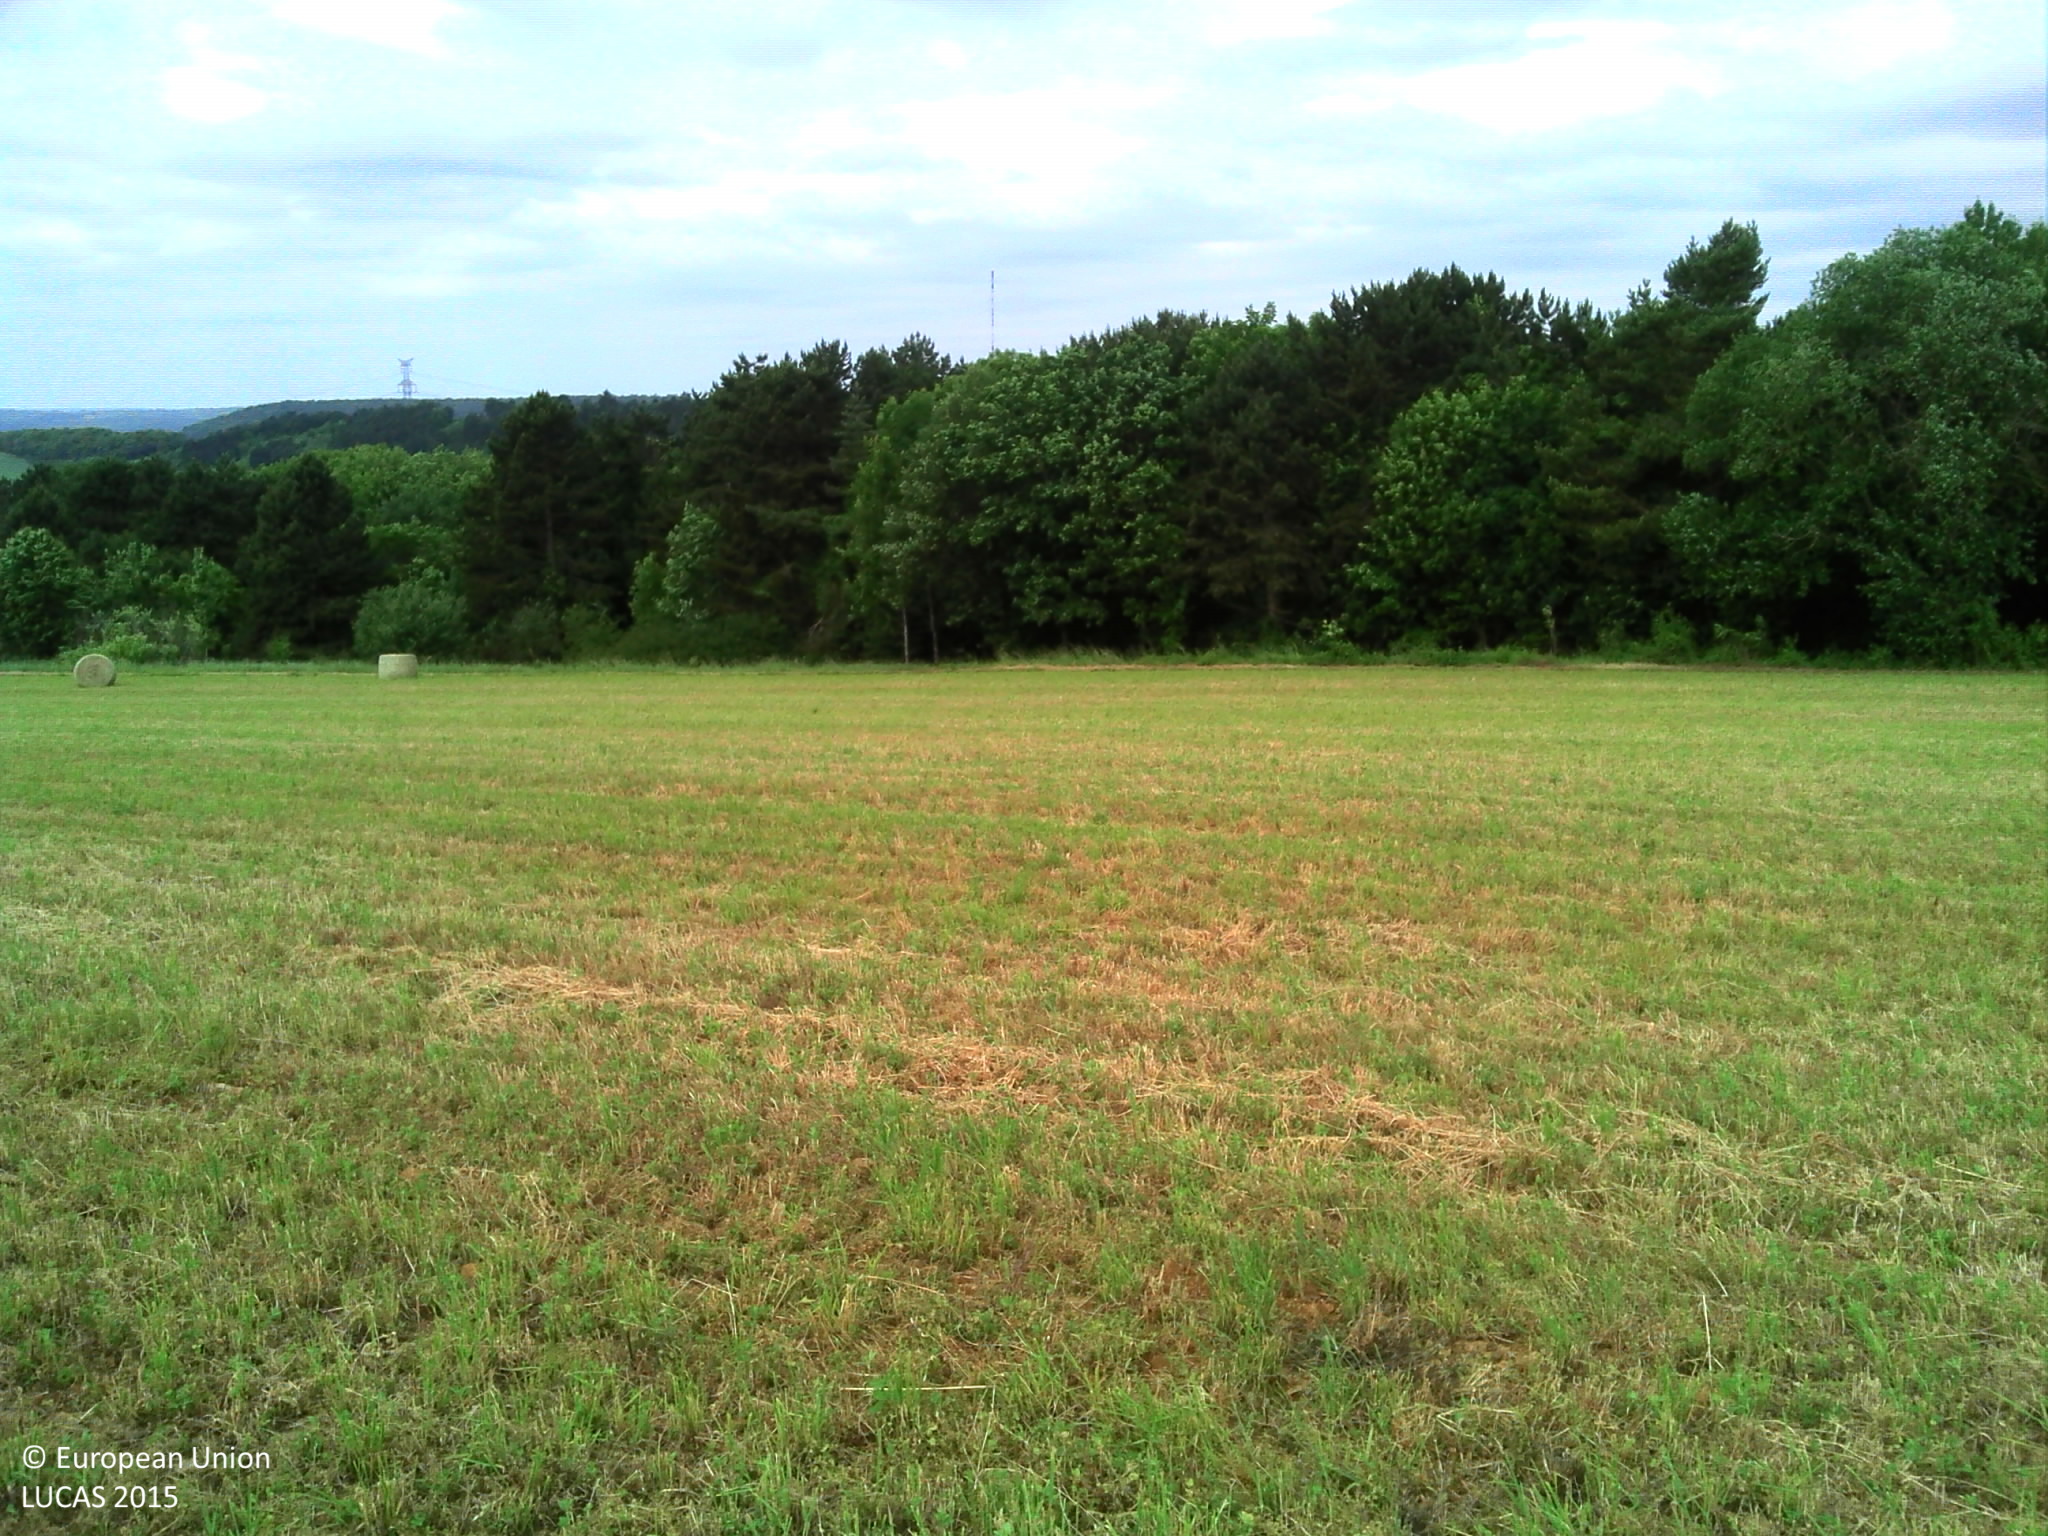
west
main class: Cropland
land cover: Temporary grasslands
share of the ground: > 75 %
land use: Agriculture (excluding fallow land and kitchen gardens)
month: June
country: FR
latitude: 48.8075
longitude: 6.2282
